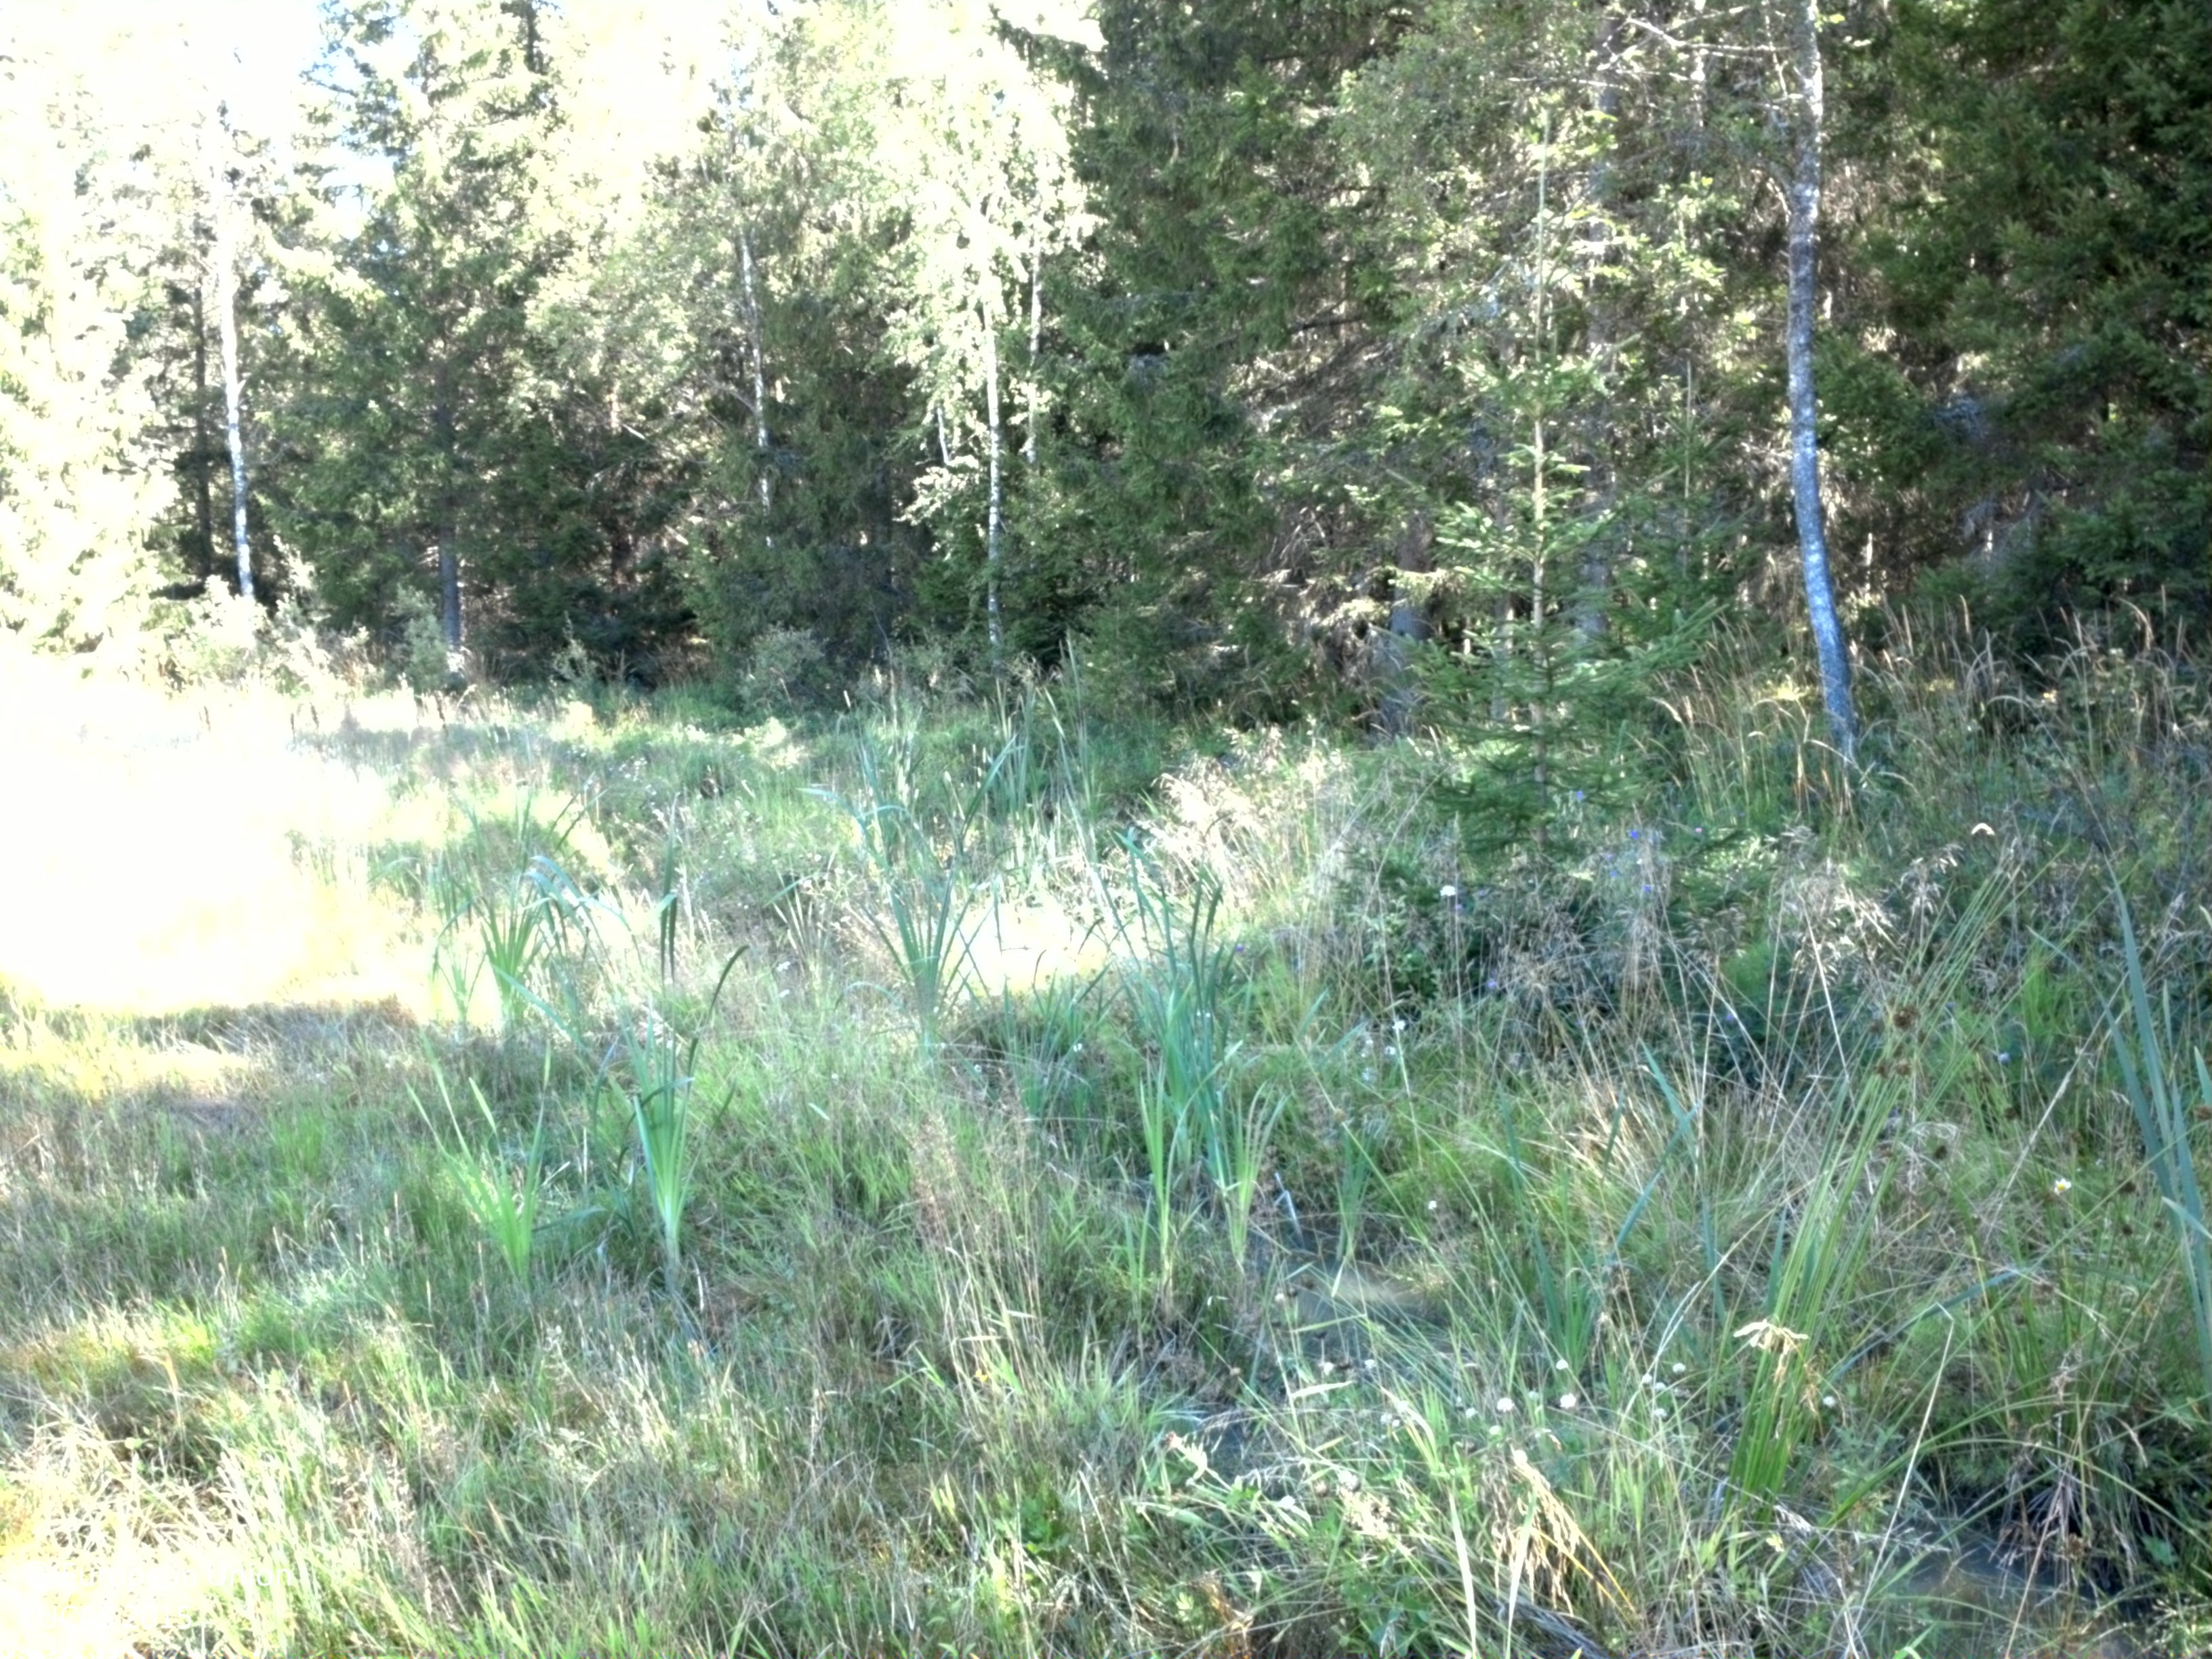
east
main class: Grassland
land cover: Grassland without tree/shrub cover
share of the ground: > 75 %
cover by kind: herbaceous plants 100 %
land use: Agriculture (excluding fallow land and kitchen gardens)
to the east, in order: Grassland without tree/shrub cover; Ditches and canals; Spruce dominated coniferous woodland; Ditches and canals; Spruce dominated coniferous woodland; Spruce dominated mixed woodland; Other coniferous woodland; Pine dominated coniferous woodland; Ditches and canals; Other coniferous woodland
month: August
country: SE
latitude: 60.1158
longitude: 16.9905
